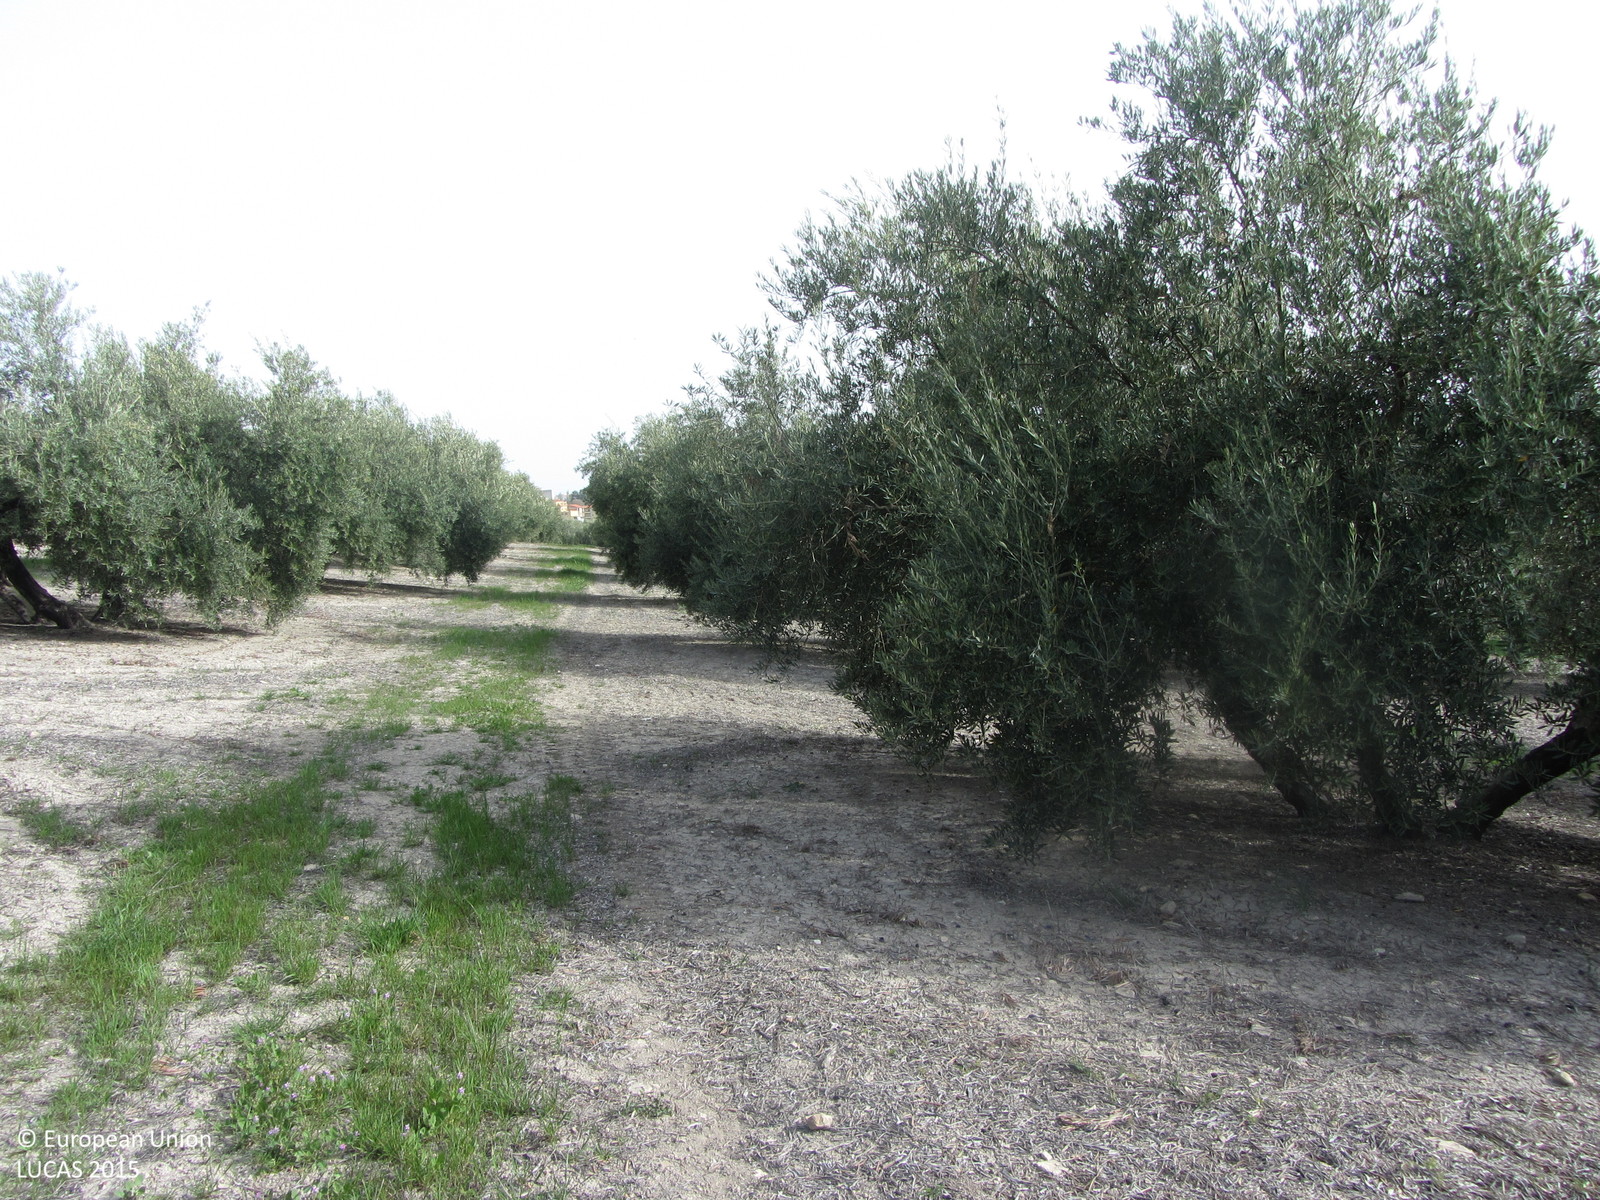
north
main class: Cropland
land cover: Olive groves
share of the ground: 50 - 75 %
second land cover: Spontaneously vegetated surfaces
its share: 10 - 25 %
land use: Agriculture (excluding fallow land and kitchen gardens)
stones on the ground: < 10 %
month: April
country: ES
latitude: 38.1054
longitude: -3.0794
